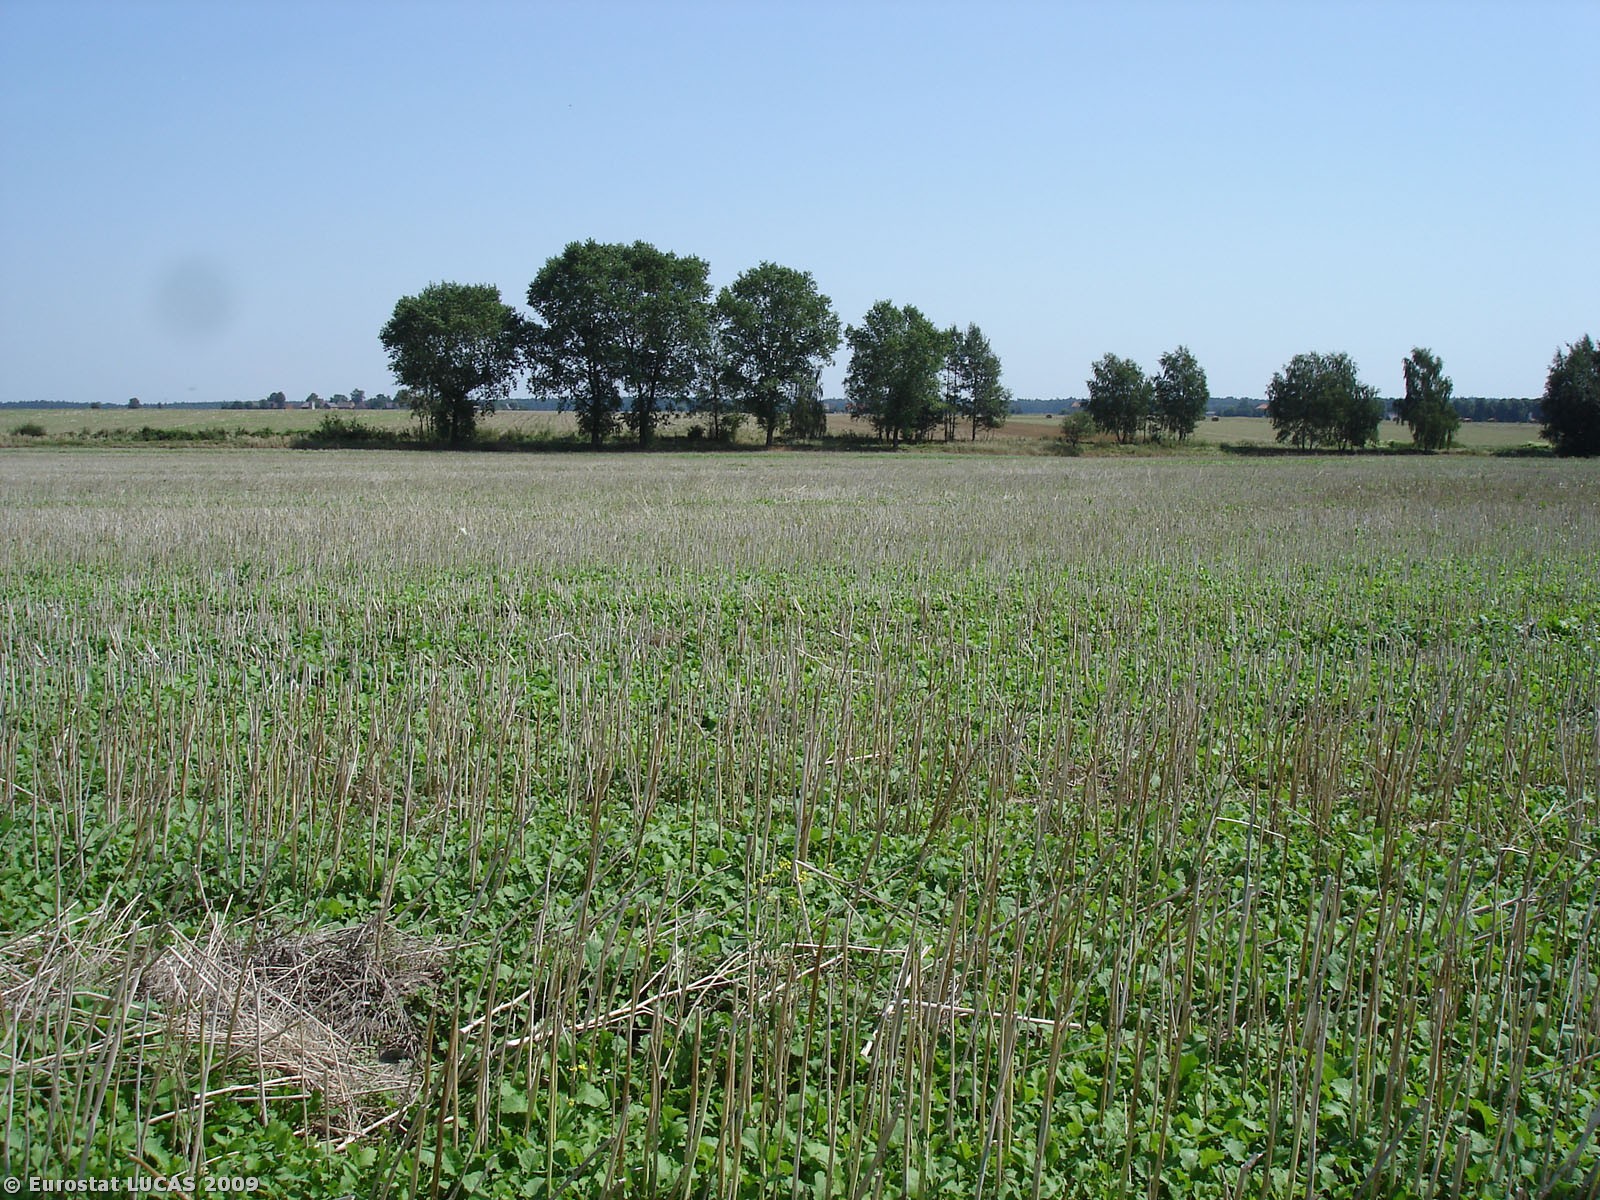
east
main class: Cropland
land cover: Other fibre and oleaginous crops
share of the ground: < 10 %
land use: Agriculture (excluding fallow land and kitchen gardens)
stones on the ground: < 10 %
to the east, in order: Other fibre and oleaginous crops; Grass margins; Ditches and canals; Grass margins; Tracks; Lines of trees; Rye
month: August
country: PL
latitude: 50.9130
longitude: 18.2814
